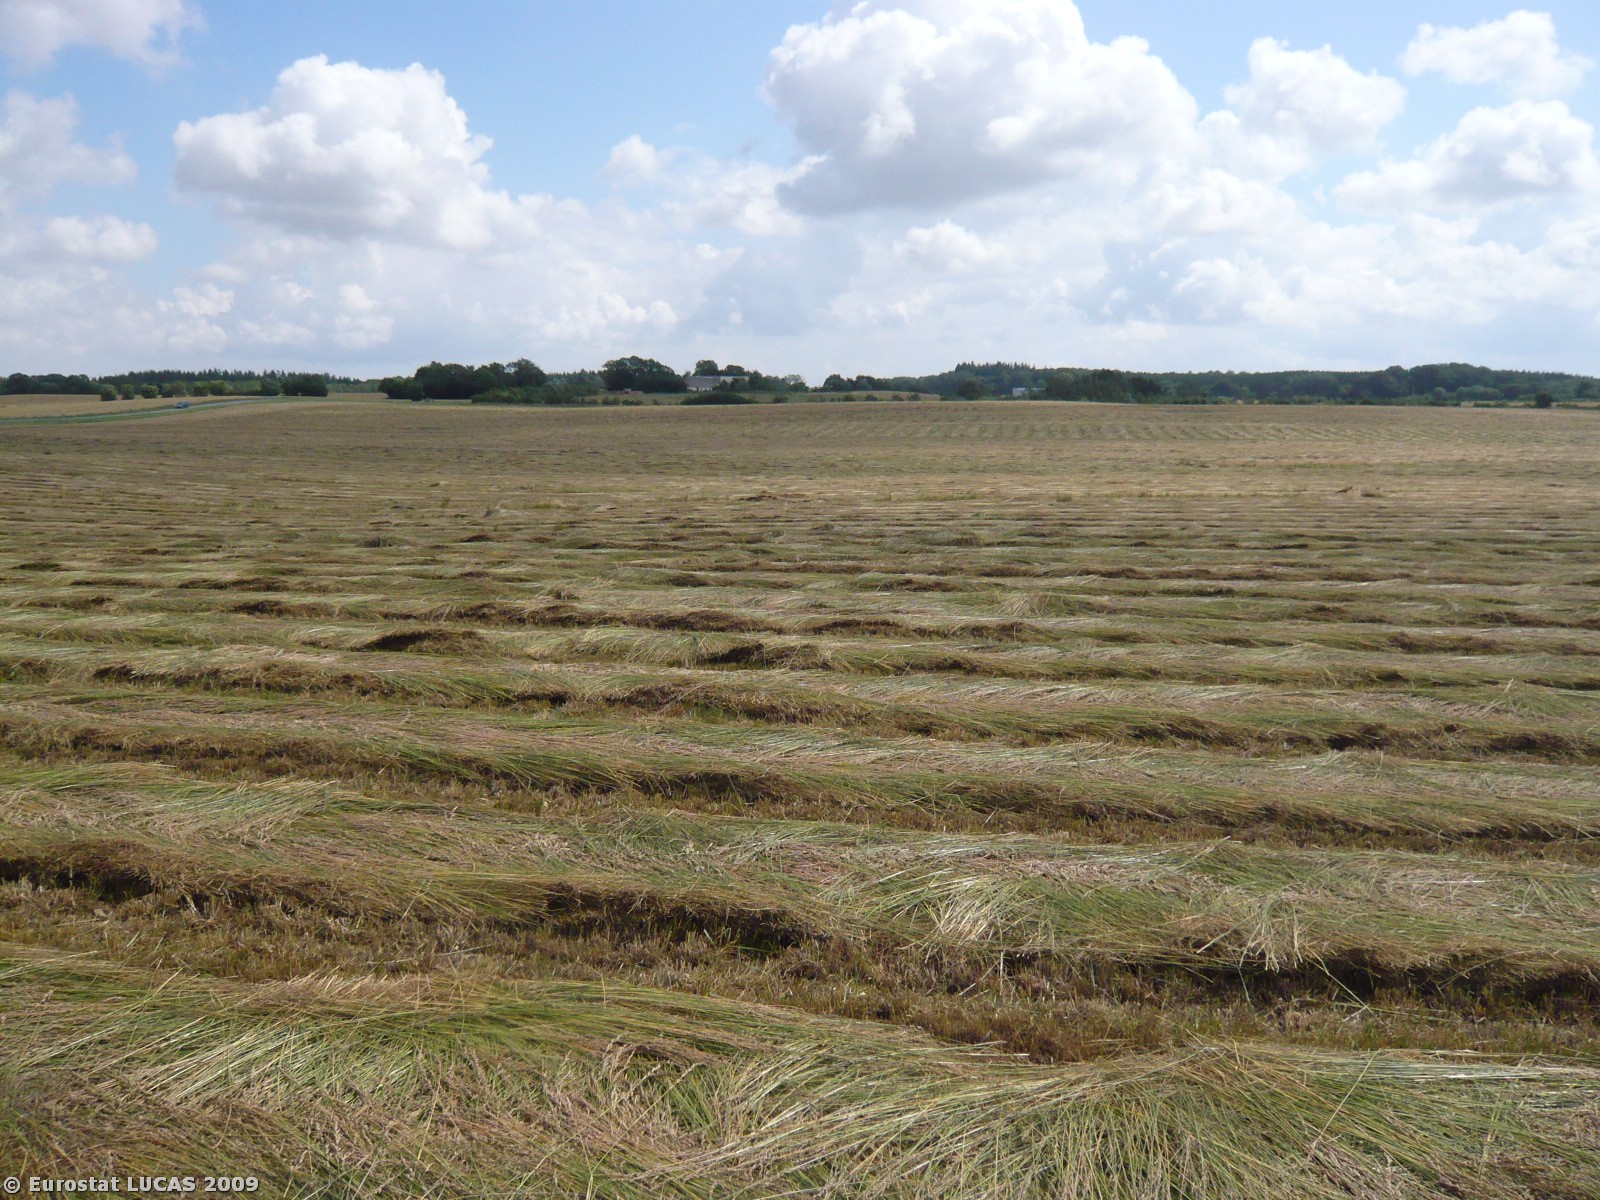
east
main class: Cropland
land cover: Temporary grasslands
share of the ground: > 75 %
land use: Agriculture (excluding fallow land and kitchen gardens)
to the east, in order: Temporary grasslands; Shrubland with sparse tree cover; Common wheat
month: July
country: DK
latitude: 55.4888
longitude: 12.0083
